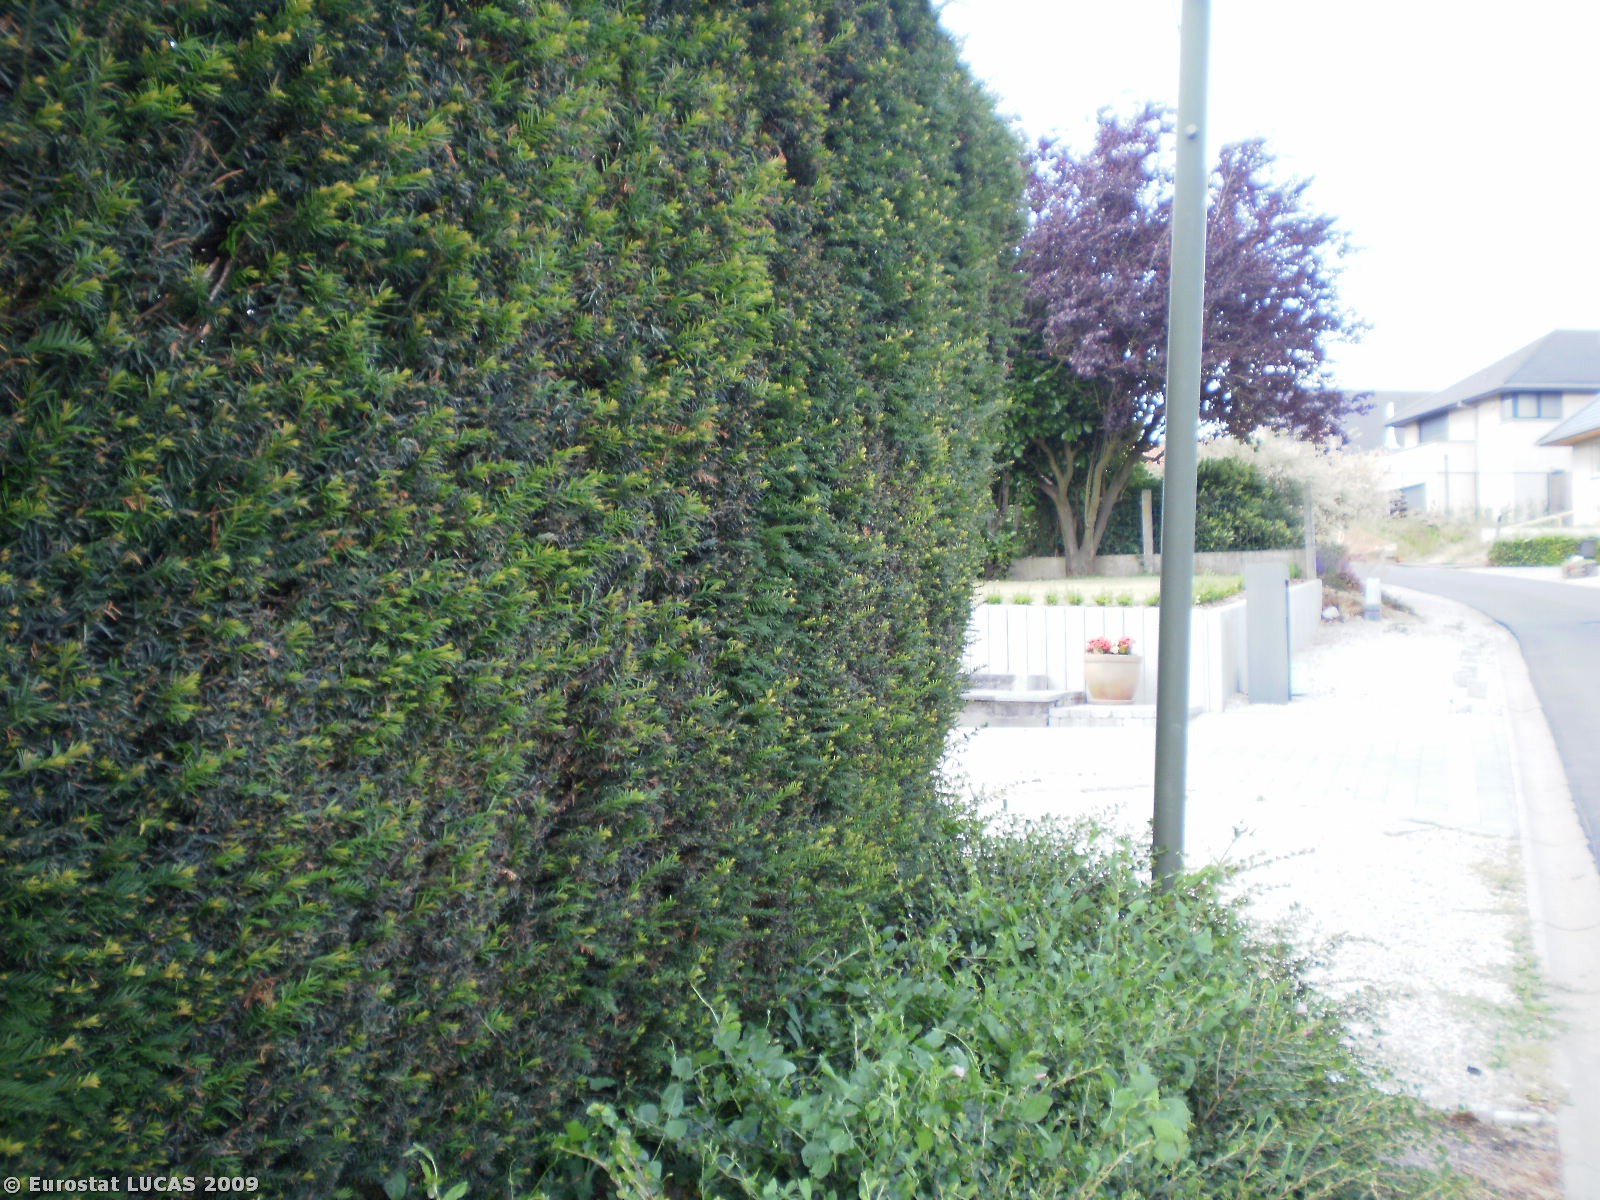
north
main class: Artificial land
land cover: Non built-up linear features
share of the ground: 25 - 50 %
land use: Residential
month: July
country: BE
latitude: 50.8858
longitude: 4.2380
